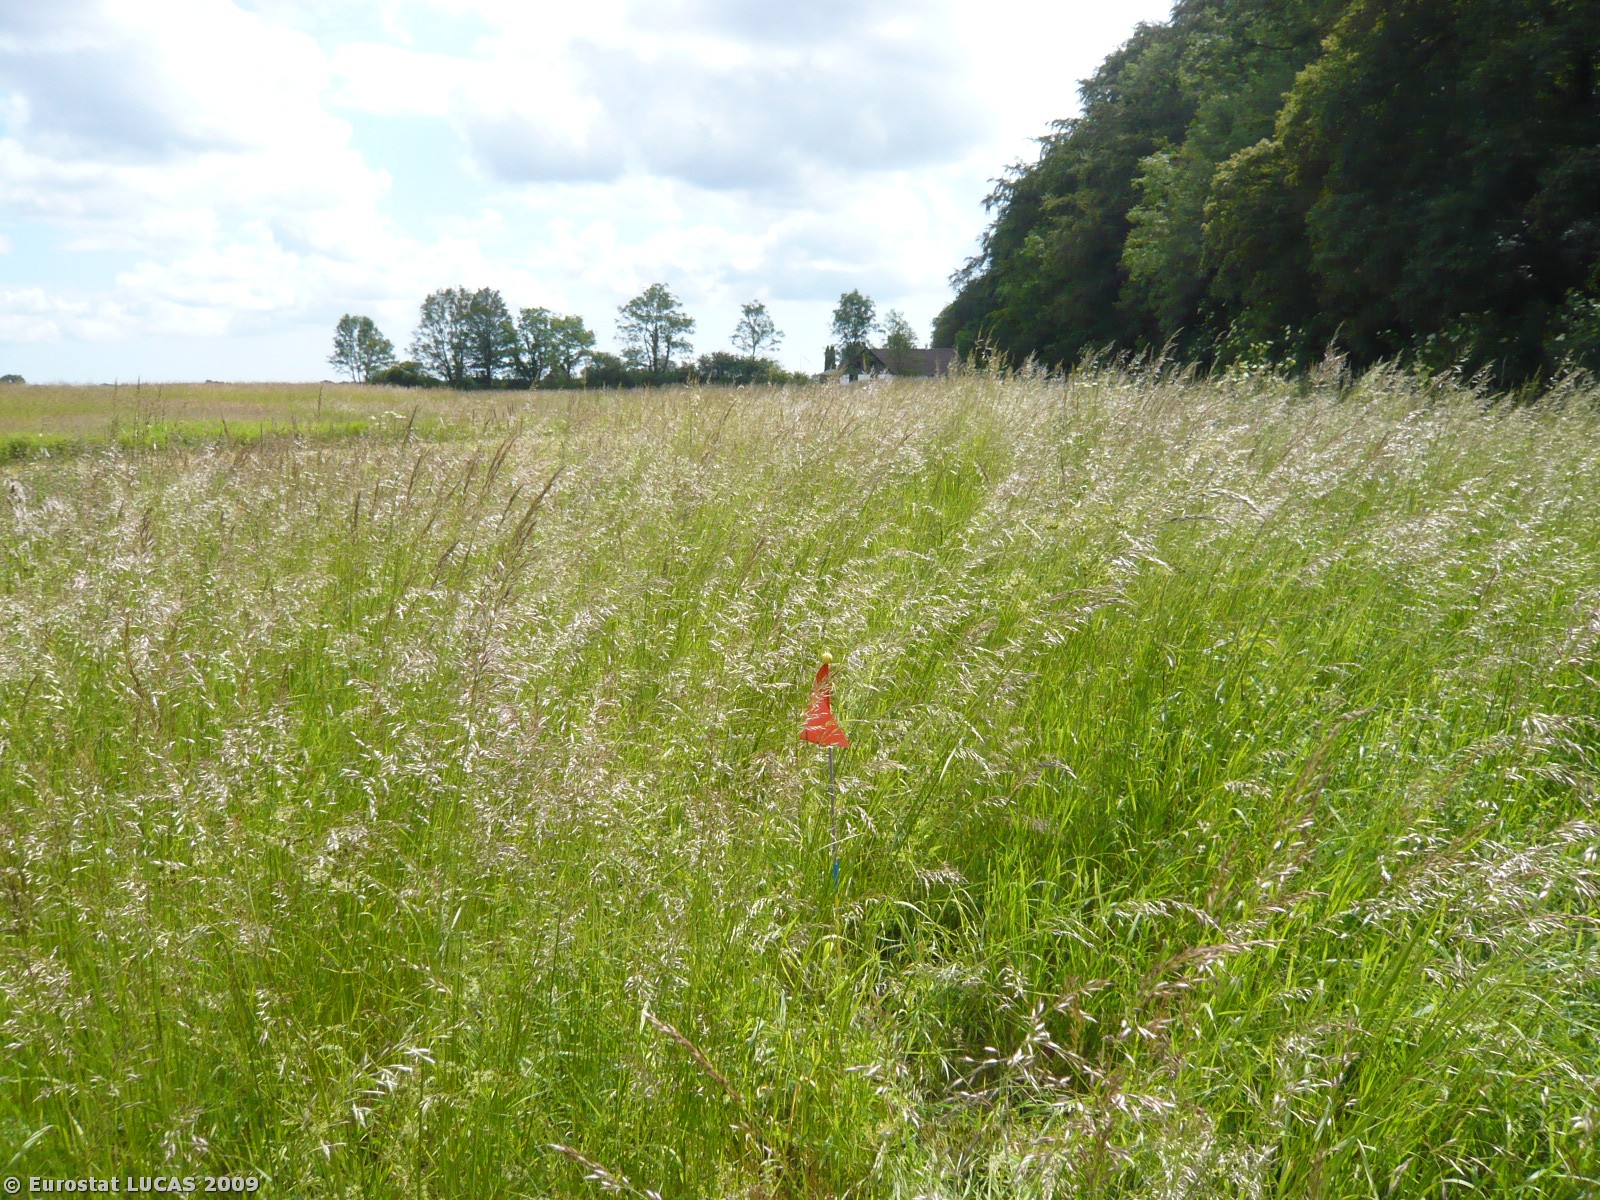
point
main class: Grassland
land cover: Grassland without tree/shrub cover
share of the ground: > 75 %
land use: Agriculture (excluding fallow land and kitchen gardens)
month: June
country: DK
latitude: 54.7563
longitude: 11.6926
